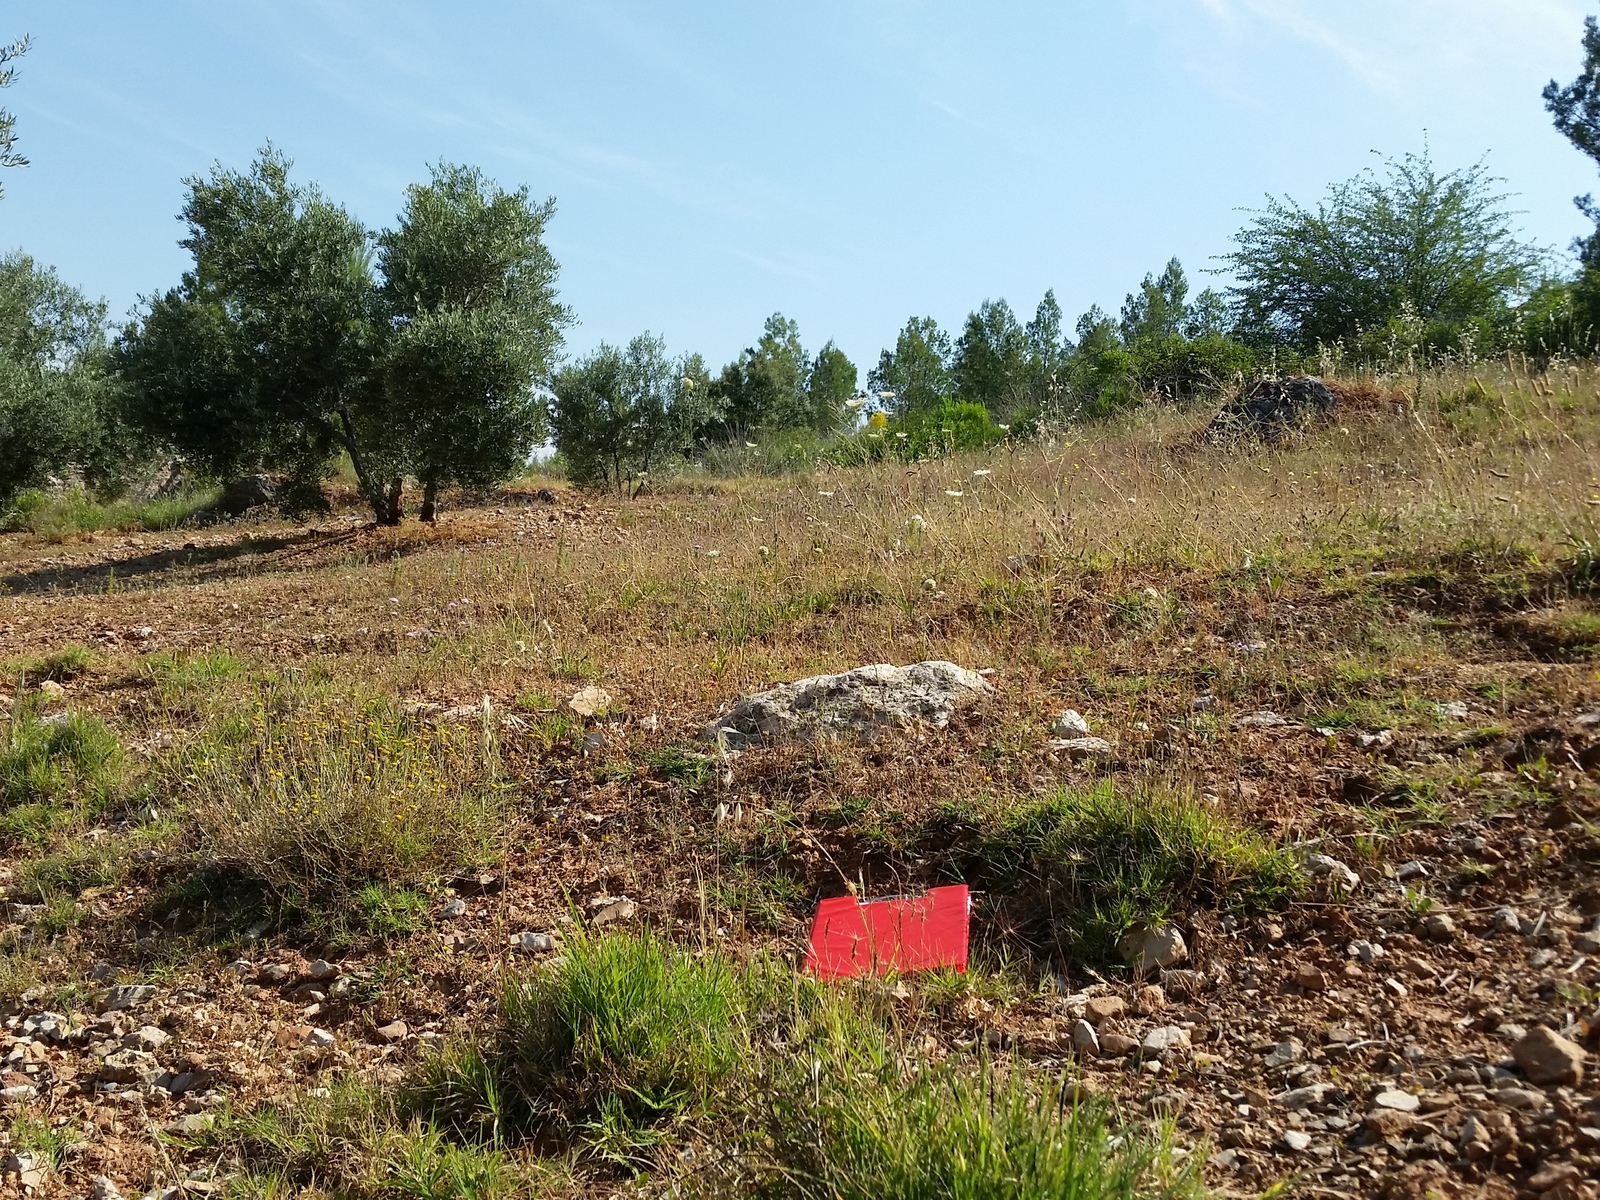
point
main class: Cropland
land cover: Olive groves
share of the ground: 50 - 75 %
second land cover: Grassland without tree/shrub cover
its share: 25 - 50 %
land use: Agriculture (excluding fallow land and kitchen gardens)
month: June
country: ES
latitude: 38.4163
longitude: -2.5394
